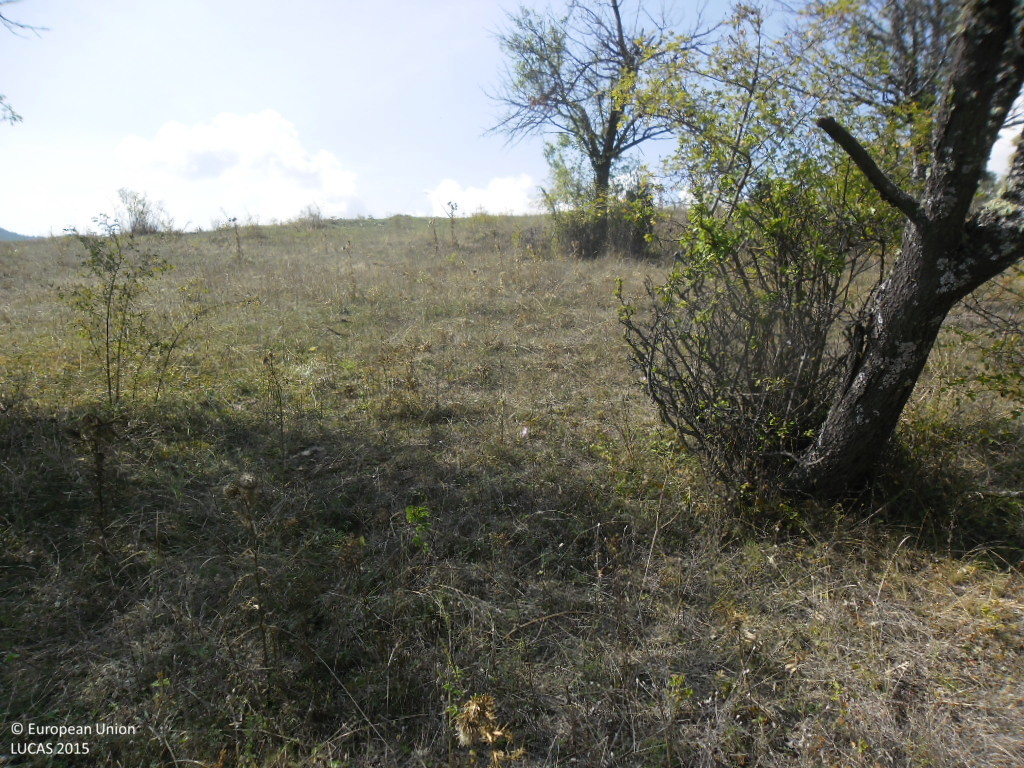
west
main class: Cropland
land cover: Other fruit trees and berries
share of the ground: 25 - 50 %
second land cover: Grassland without tree/shrub cover
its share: > 75 %
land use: Agriculture (excluding fallow land and kitchen gardens)
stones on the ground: < 10 %
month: September
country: BG
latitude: 41.8884
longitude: 22.9770
